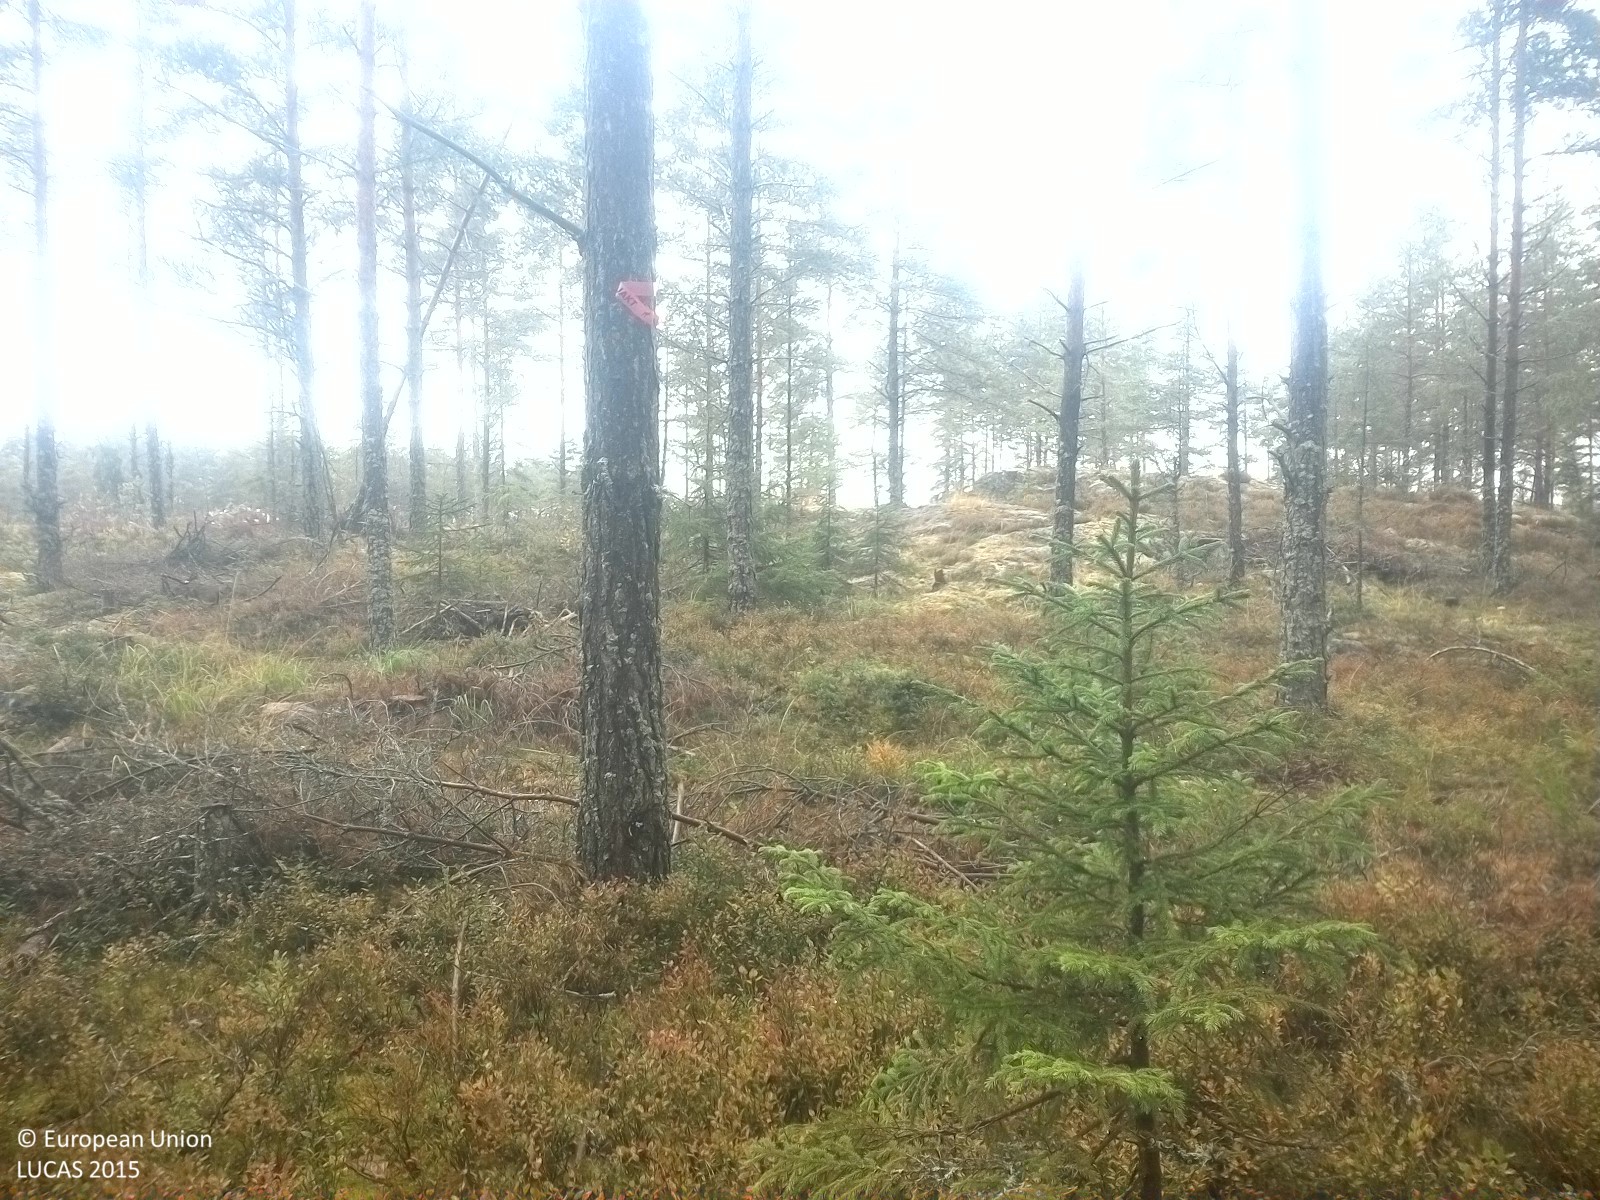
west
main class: Woodland
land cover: Pine dominated coniferous woodland
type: boreal forest
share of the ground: 25 - 50 %
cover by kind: herbaceous plants 50 %, coniferous forest trees 30 %, lichens and mosses 10 %, broadleaved forest trees 5 %, shrubs 5 %
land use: Forestry
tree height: > 5 m
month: September
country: SE
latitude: 58.8323
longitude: 16.2481
